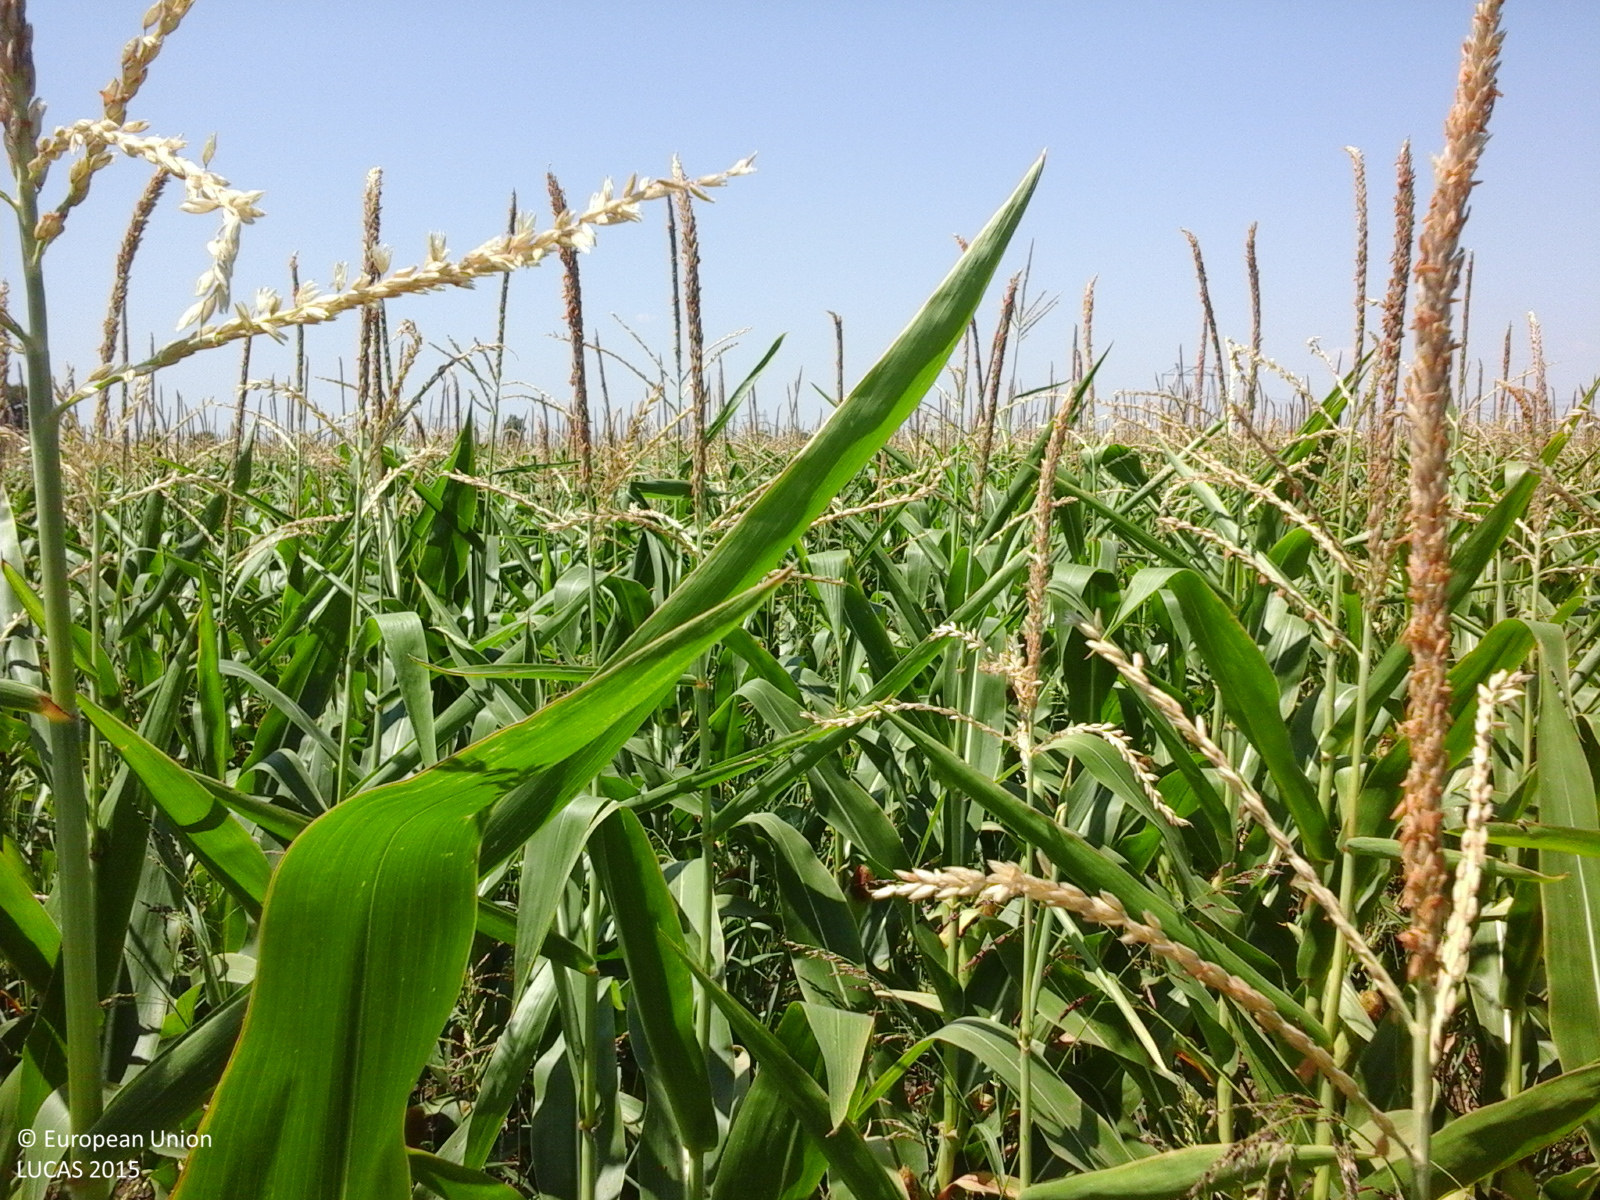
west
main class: Cropland
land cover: Maize
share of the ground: > 75 %
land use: Agriculture (excluding fallow land and kitchen gardens)
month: July
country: RO
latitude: 44.2037
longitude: 27.0069
